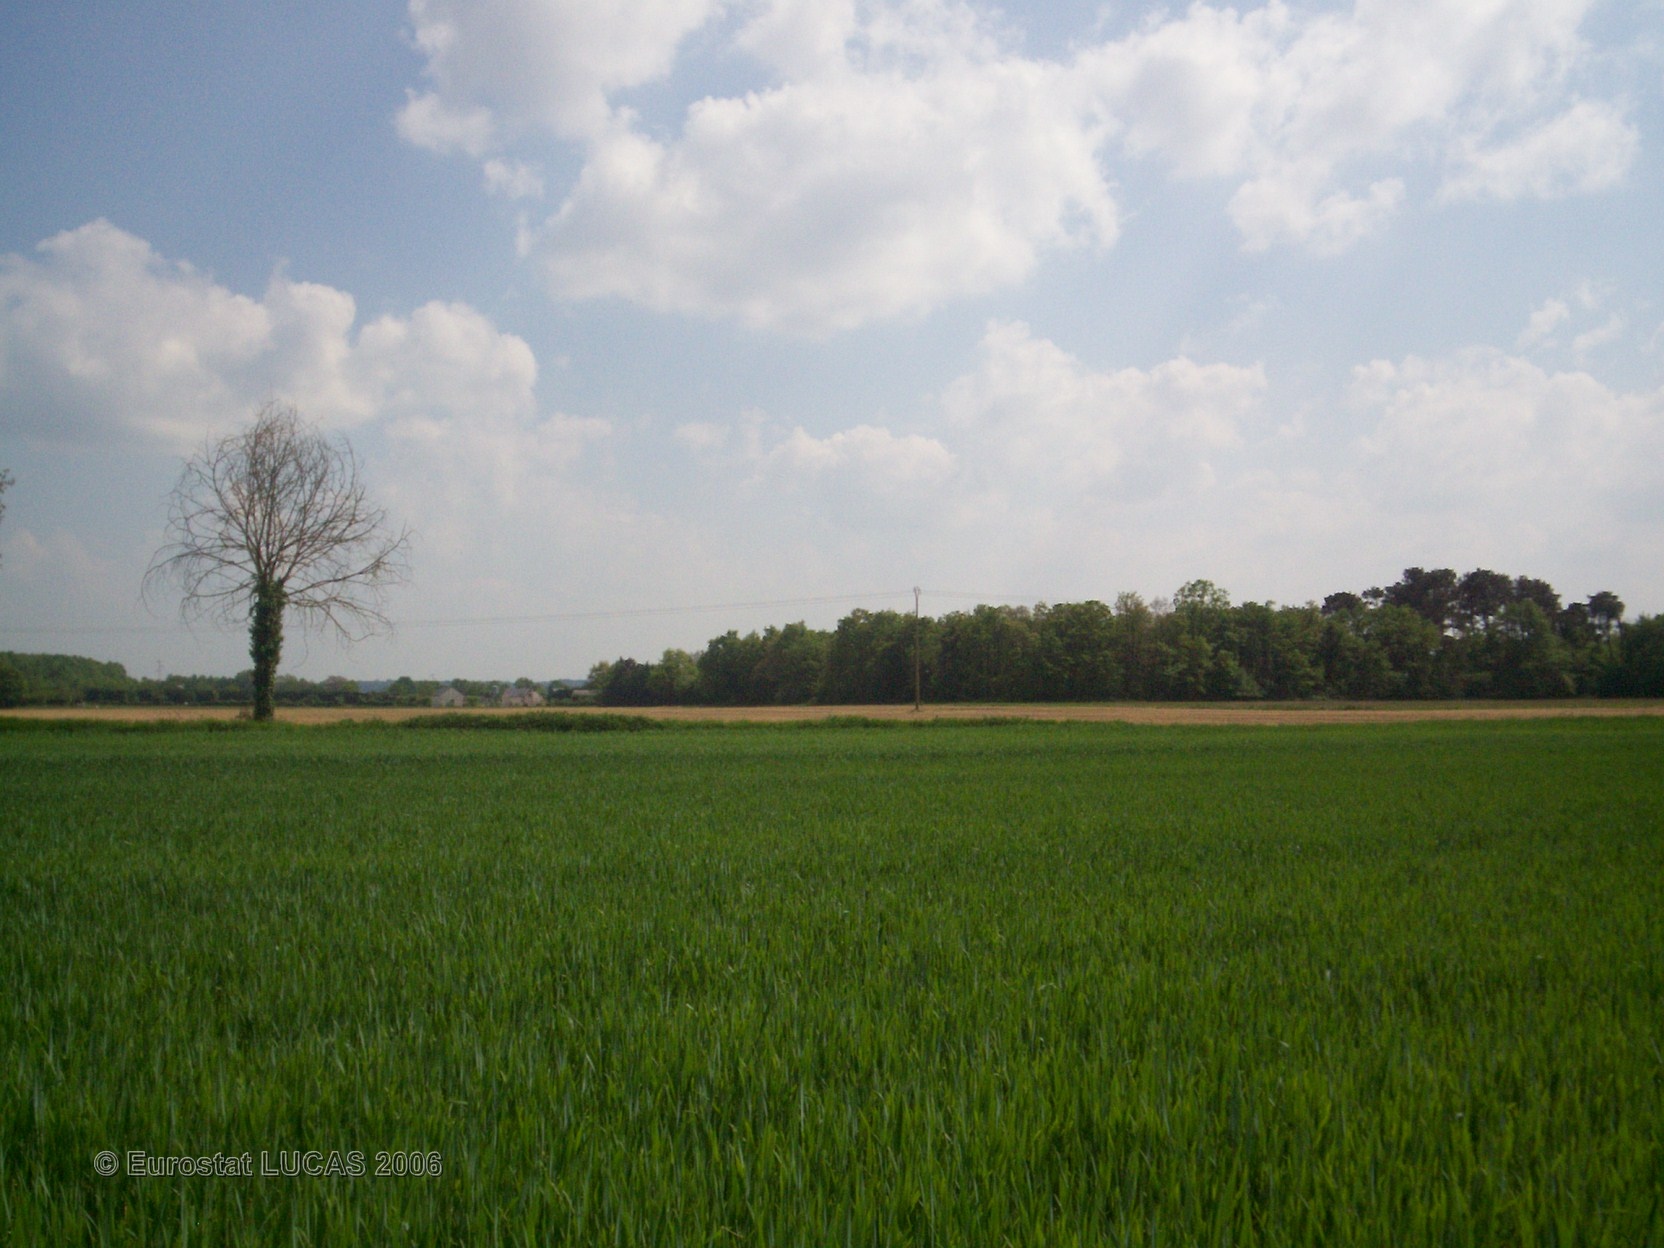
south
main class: Cropland
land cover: Common wheat
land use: Agriculture (excluding fallow land and kitchen gardens)
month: May
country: FR
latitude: 47.6580
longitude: 0.1886
